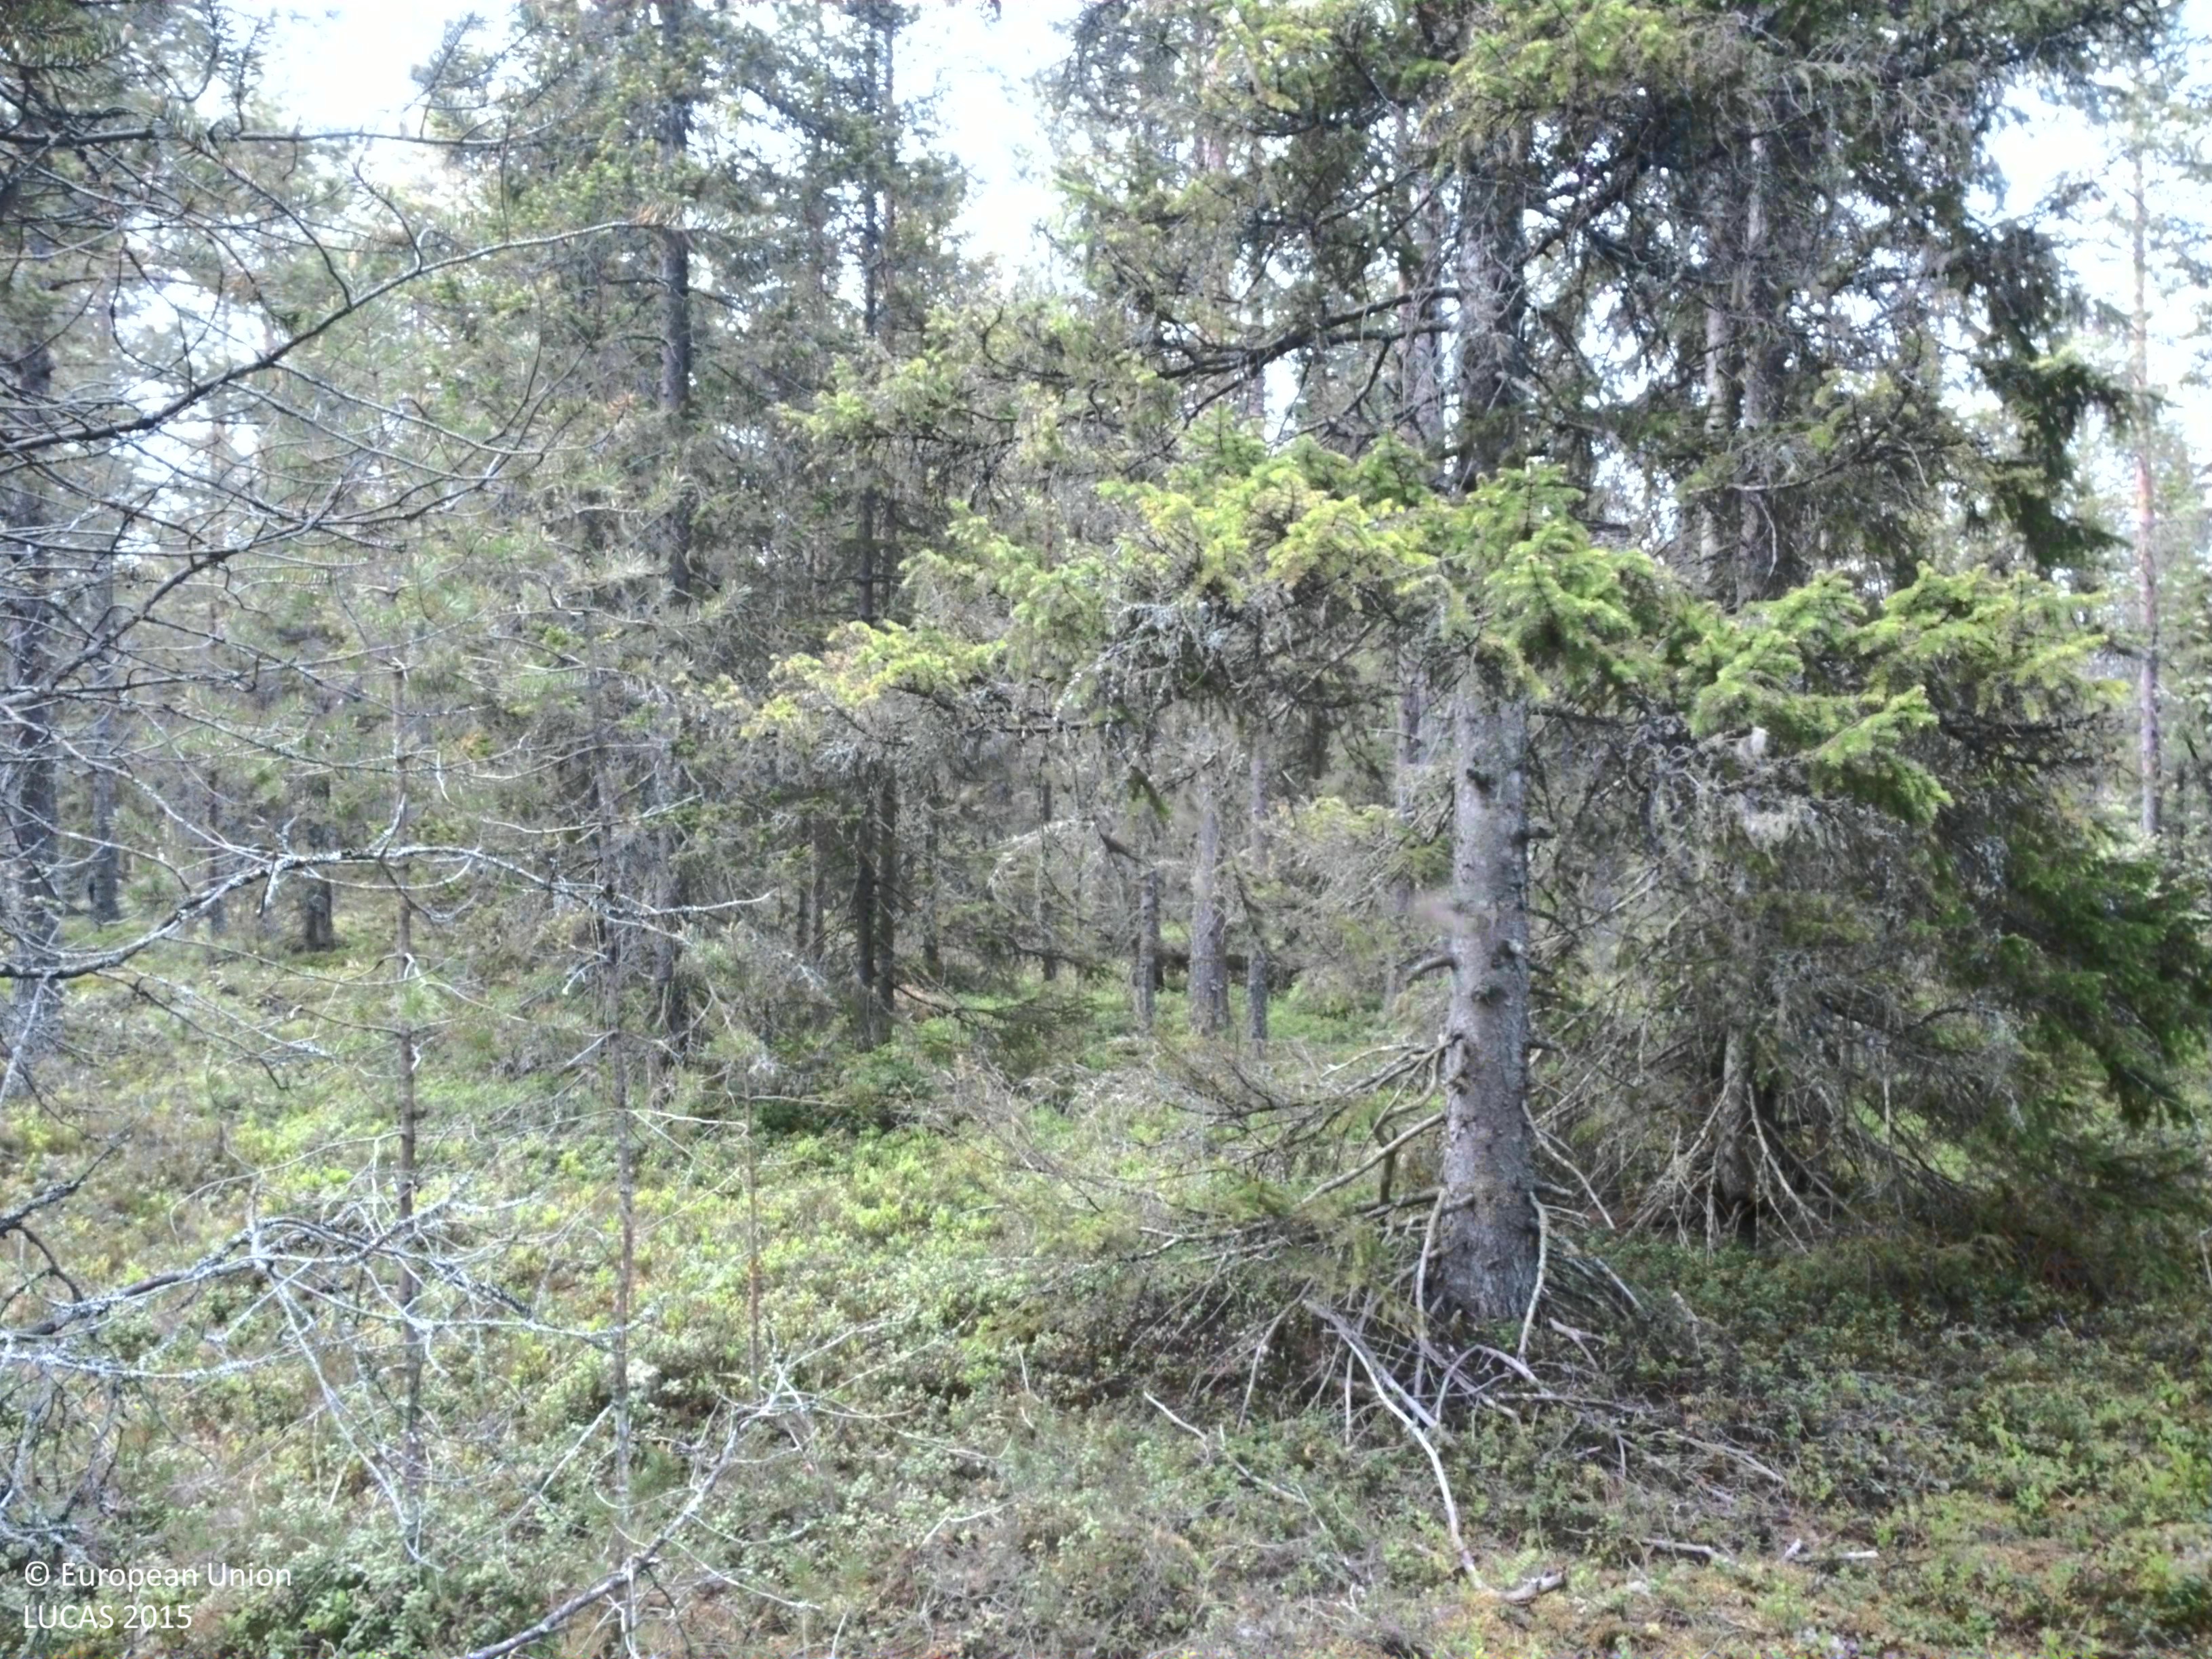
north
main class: Woodland
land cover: Other coniferous woodland
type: boreal forest
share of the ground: 25 - 50 %
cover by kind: coniferous forest trees 50 %, shrubs 40 %, herbaceous plants 5 %, lichens and mosses 5 %
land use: Amenities, museums, leisure
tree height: > 5 m
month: June
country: SE
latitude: 63.8201
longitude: 20.6503
